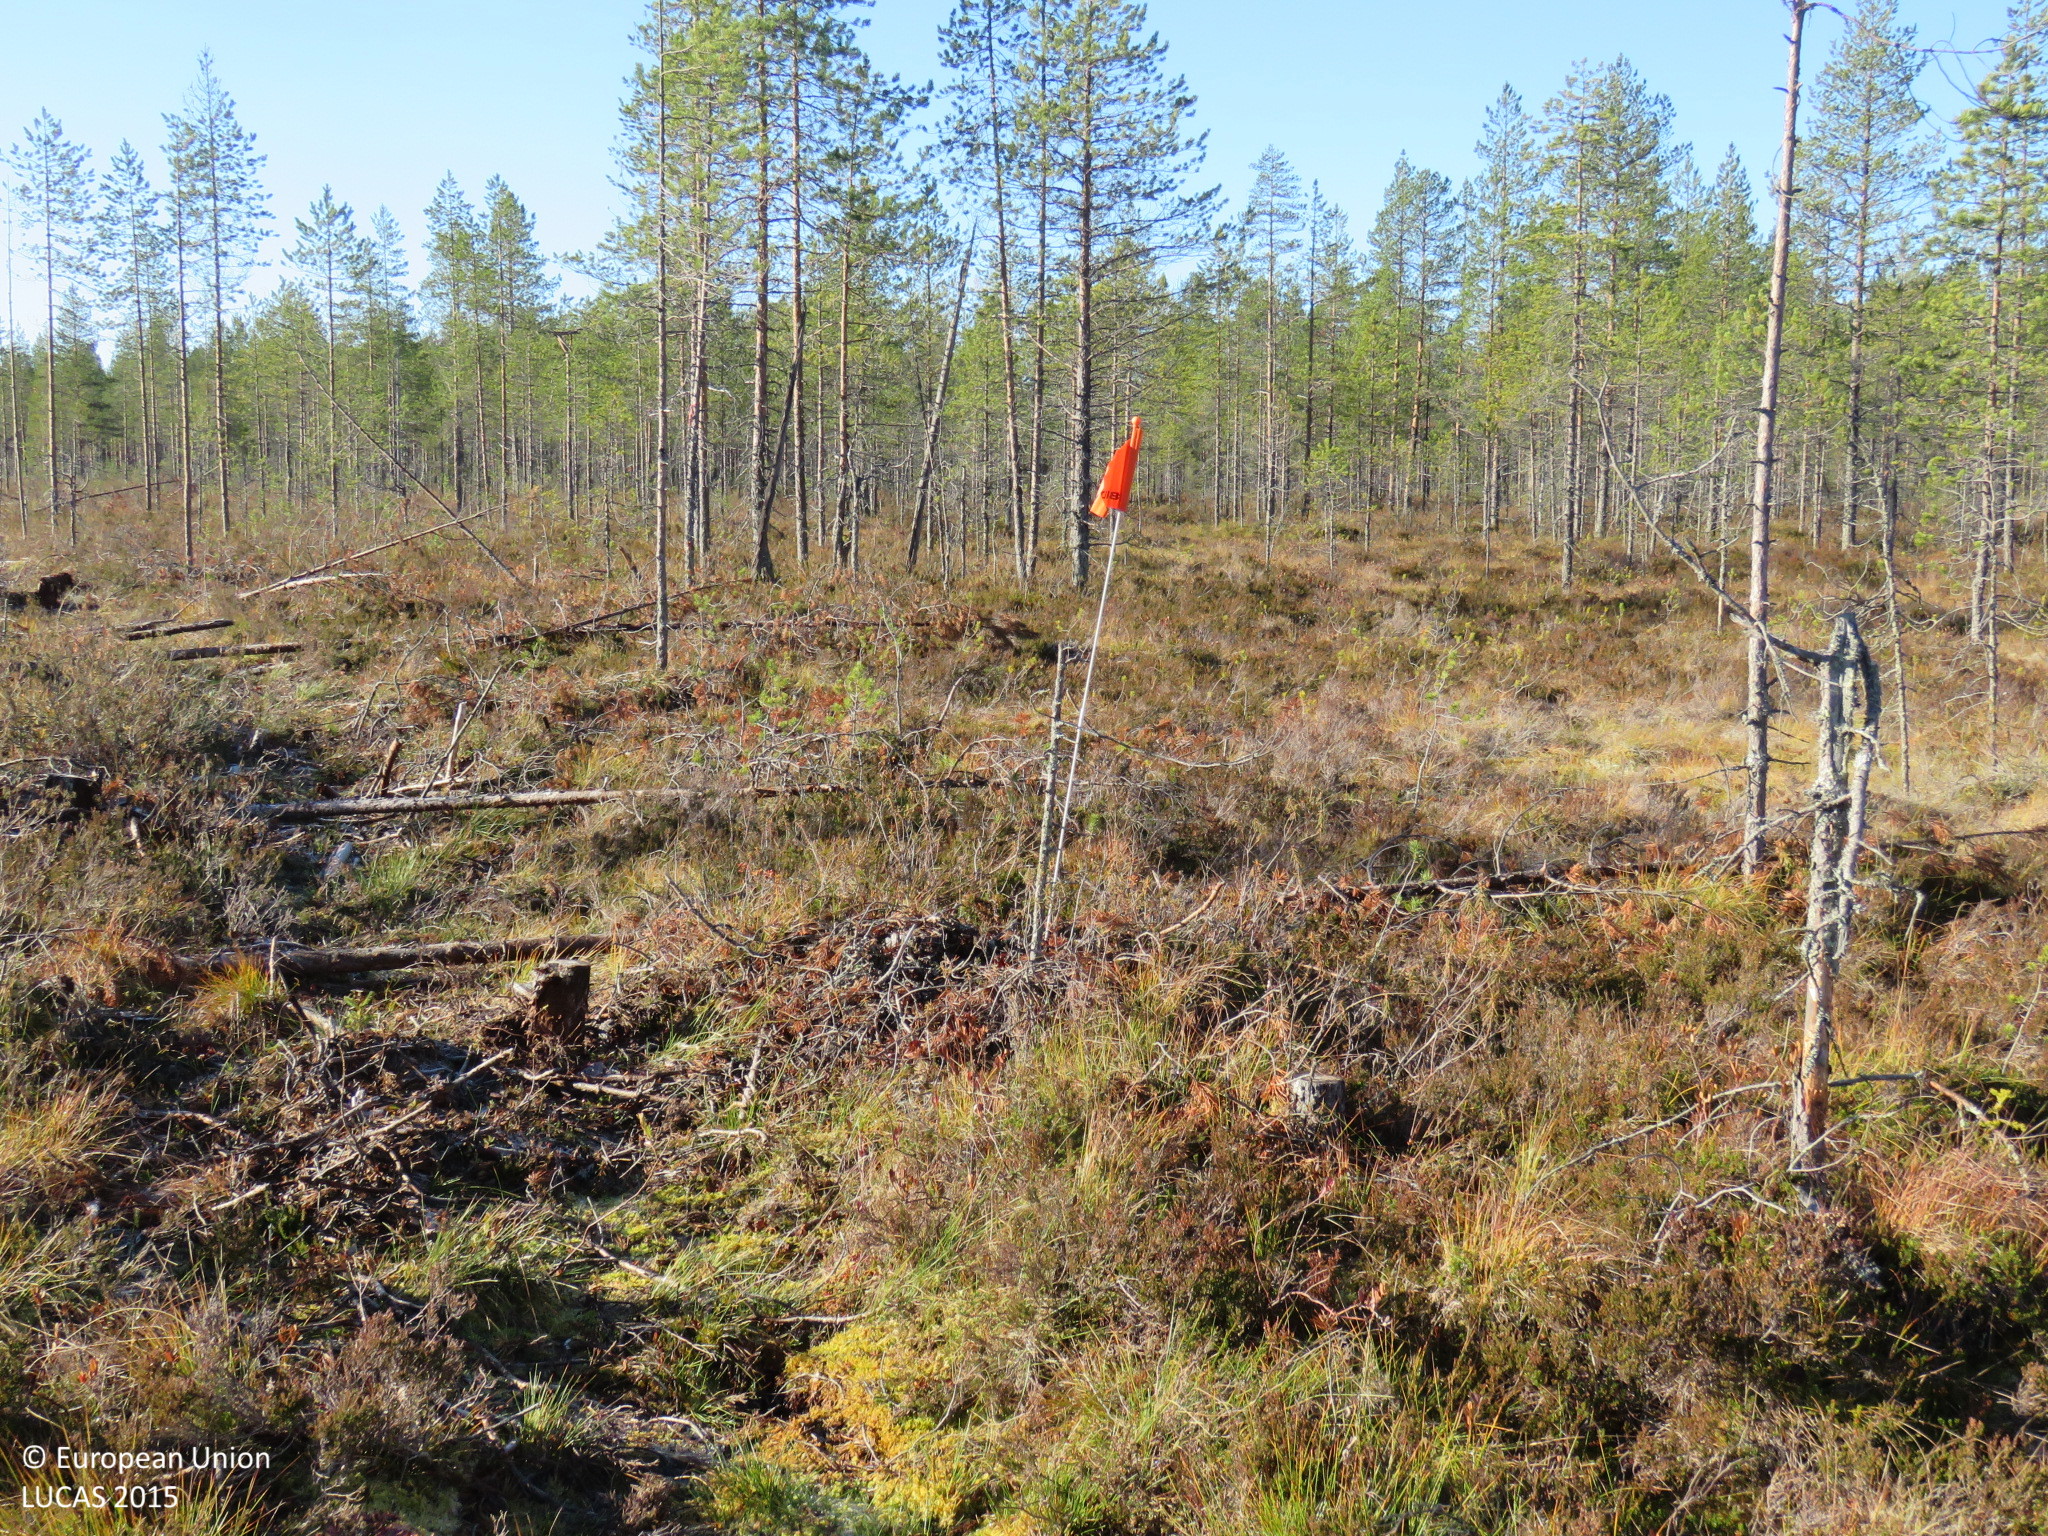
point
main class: Woodland
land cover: Pine dominated coniferous woodland
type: mire and swamp forests
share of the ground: 25 - 50 %
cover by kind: coniferous forest trees 40 %, shrubs 40 %, herbaceous plants 15 %, lichens and mosses 5 %
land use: Forestry
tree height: > 5 m
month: October
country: FI
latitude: 64.3949
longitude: 27.3748
